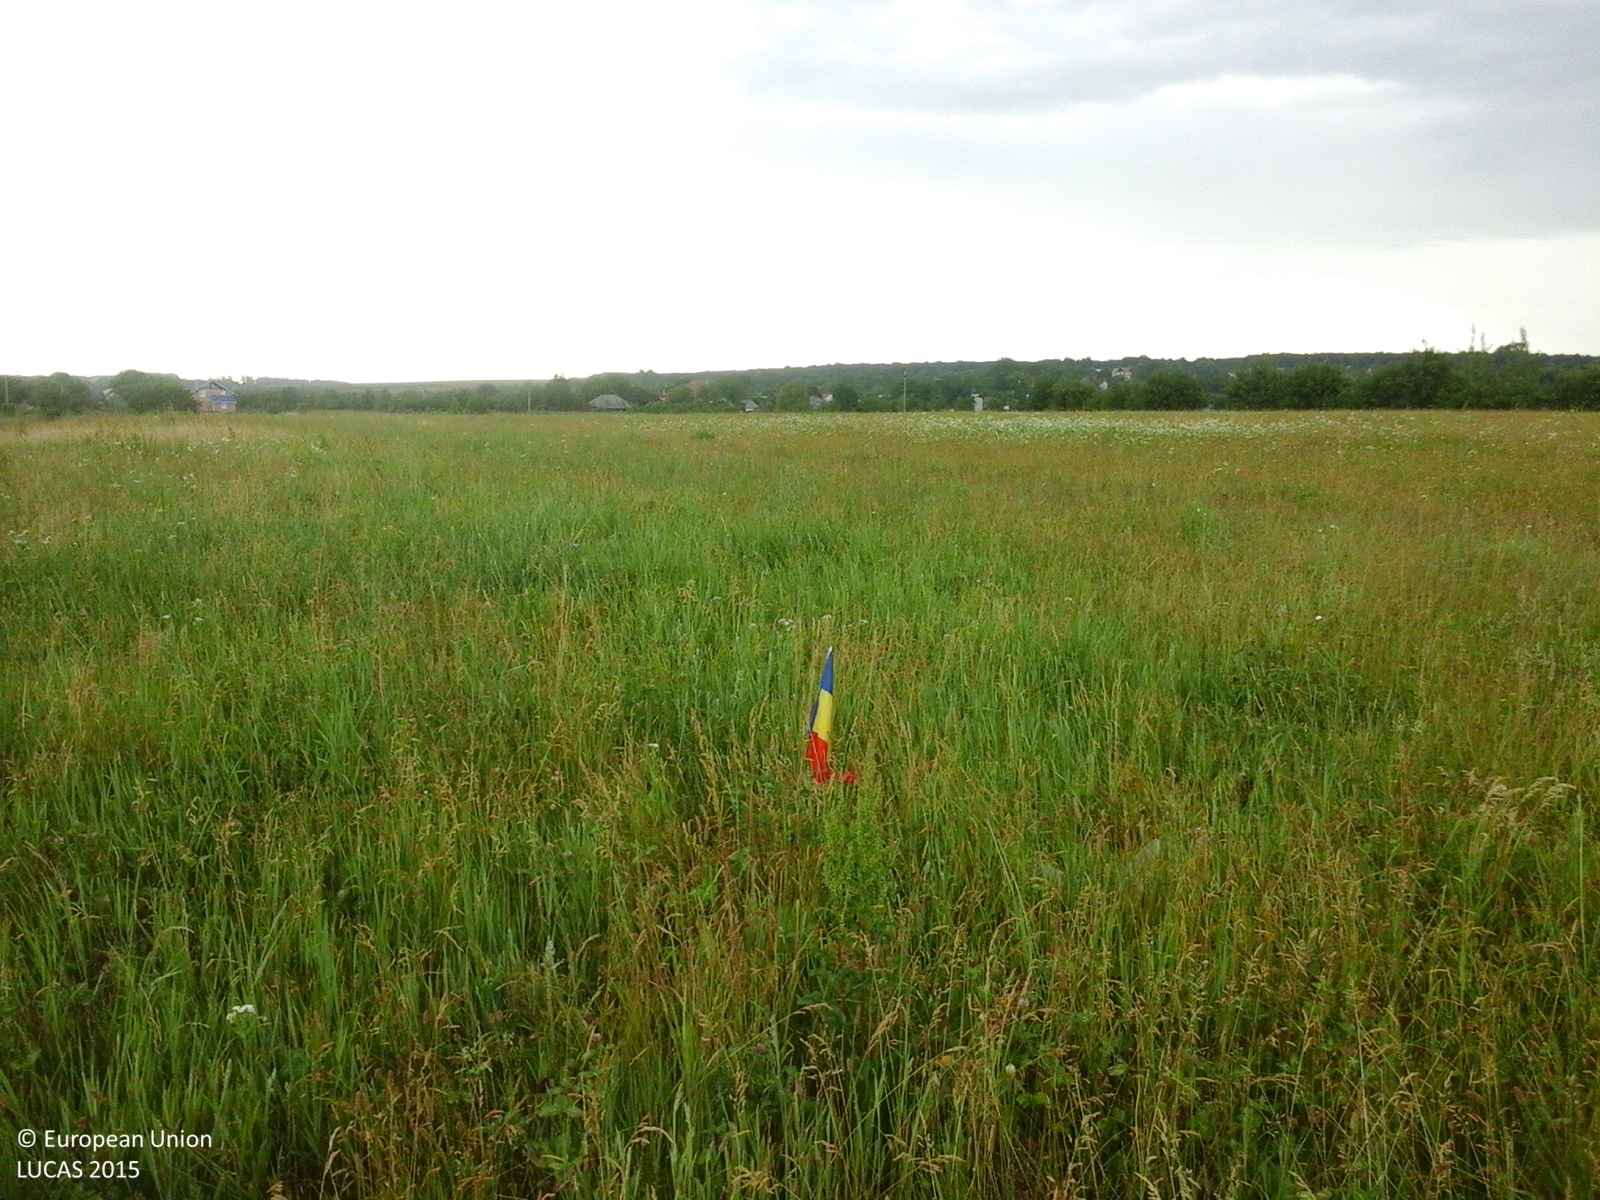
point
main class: Grassland
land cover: Grassland without tree/shrub cover
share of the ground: > 75 %
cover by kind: herbaceous plants 100 %
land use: Agriculture (excluding fallow land and kitchen gardens)
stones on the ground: < 10 %
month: June
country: RO
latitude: 47.3739
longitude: 26.2518
